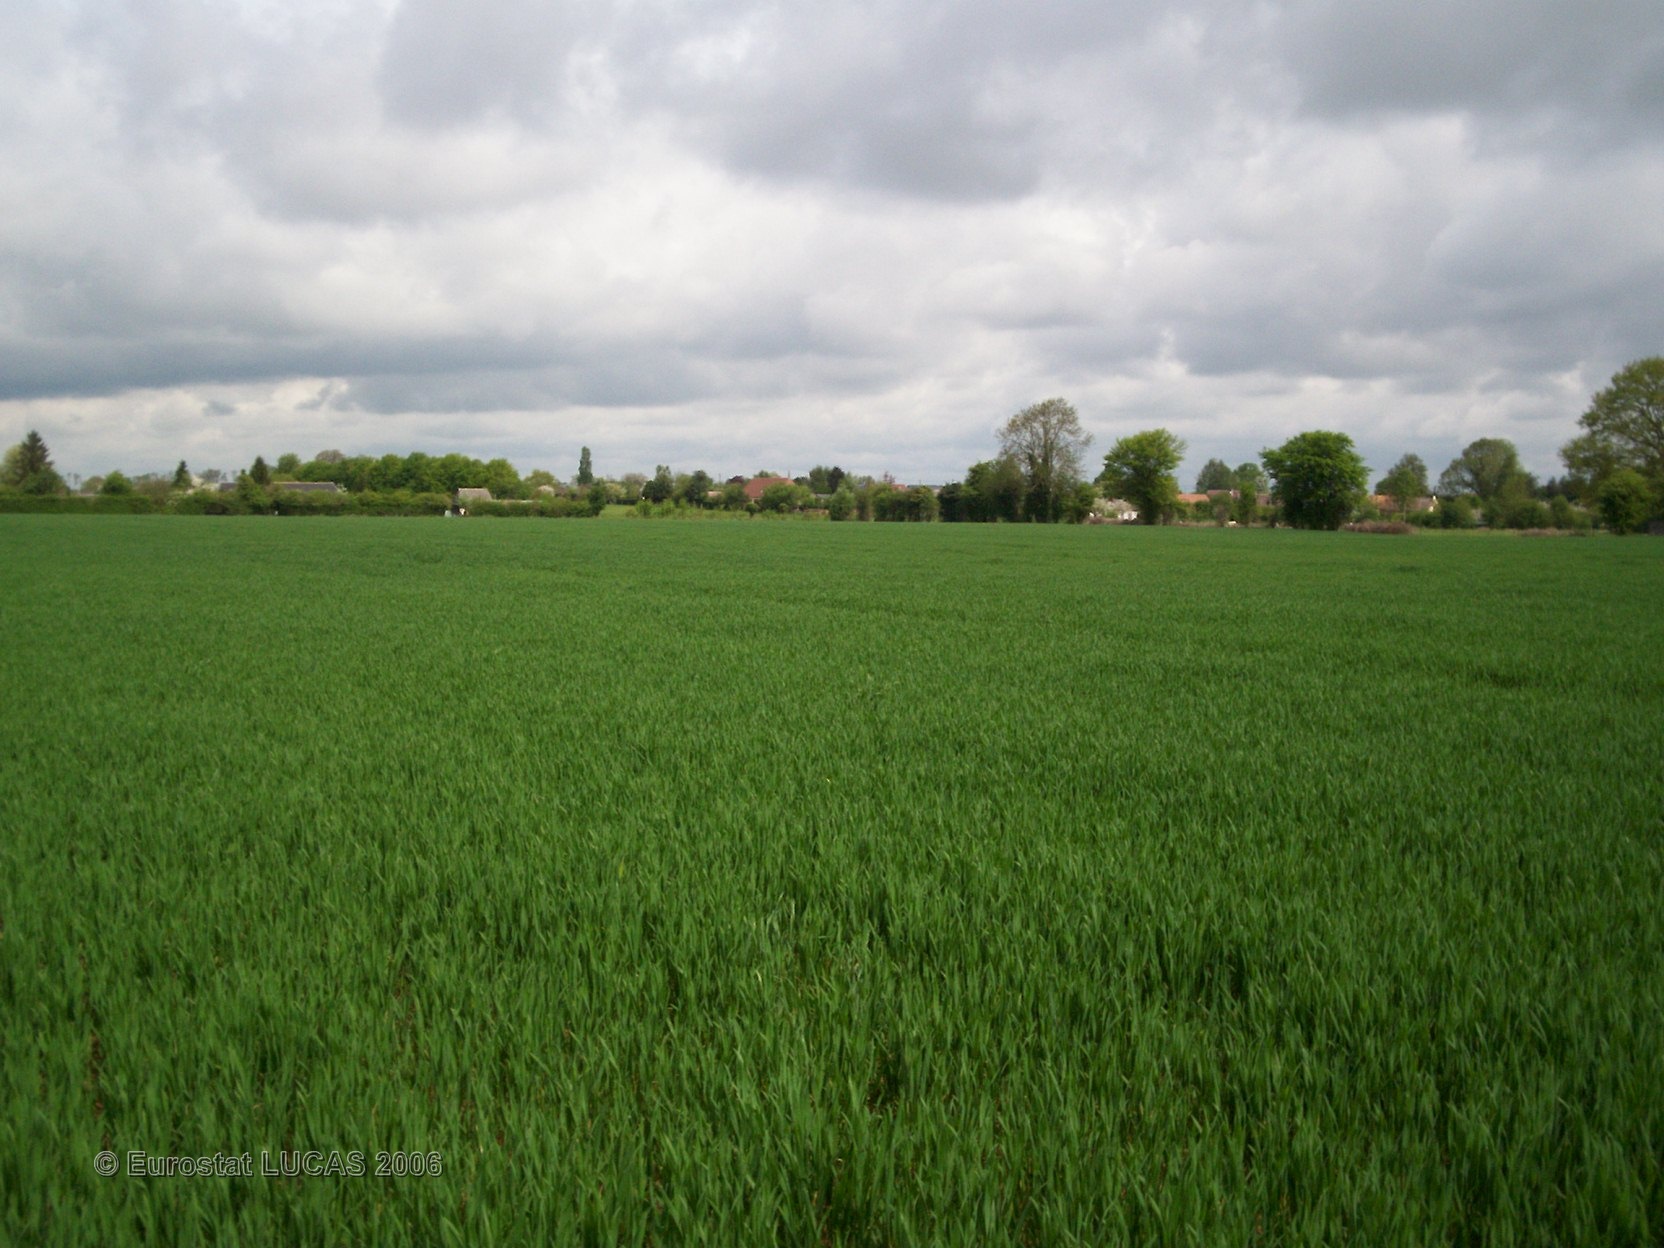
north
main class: Cropland
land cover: Common wheat
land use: Agriculture (excluding fallow land and kitchen gardens)
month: May
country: FR
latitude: 49.0638
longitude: 0.5168
